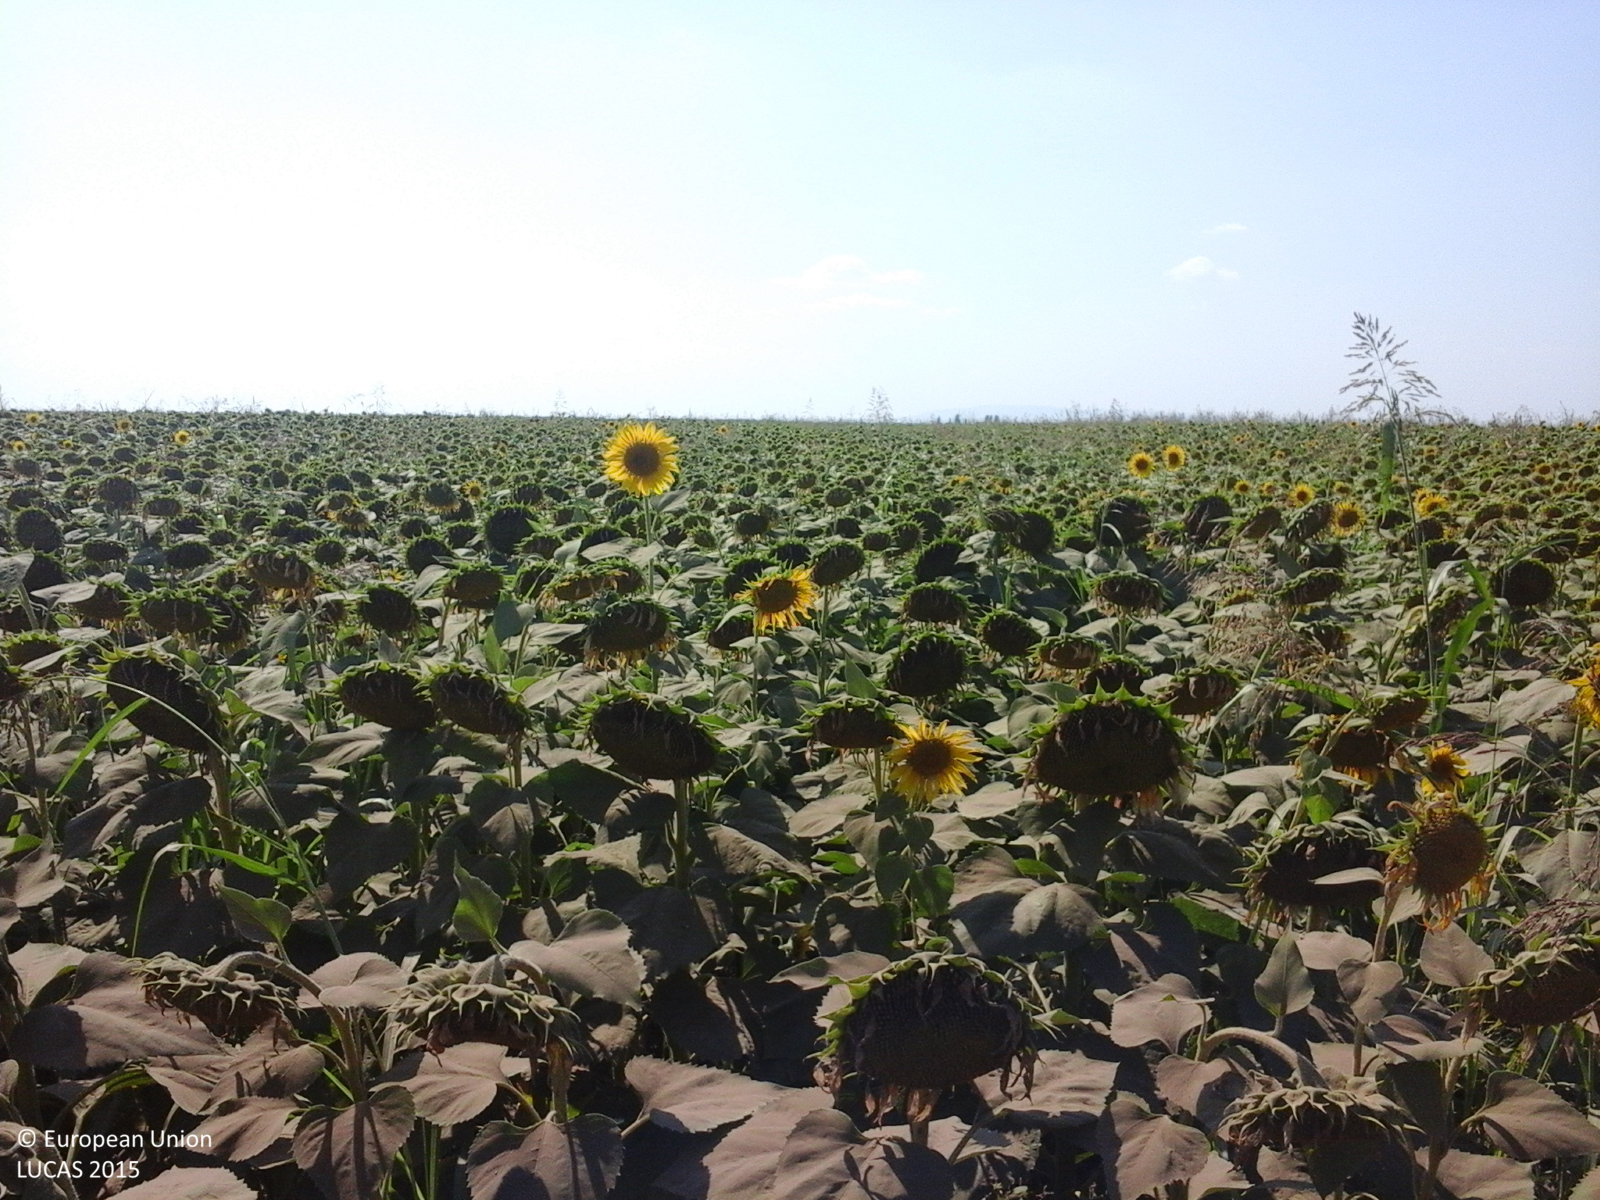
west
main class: Cropland
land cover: Maize
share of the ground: > 75 %
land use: Agriculture (excluding fallow land and kitchen gardens)
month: July
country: RO
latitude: 45.0443
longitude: 26.9290
